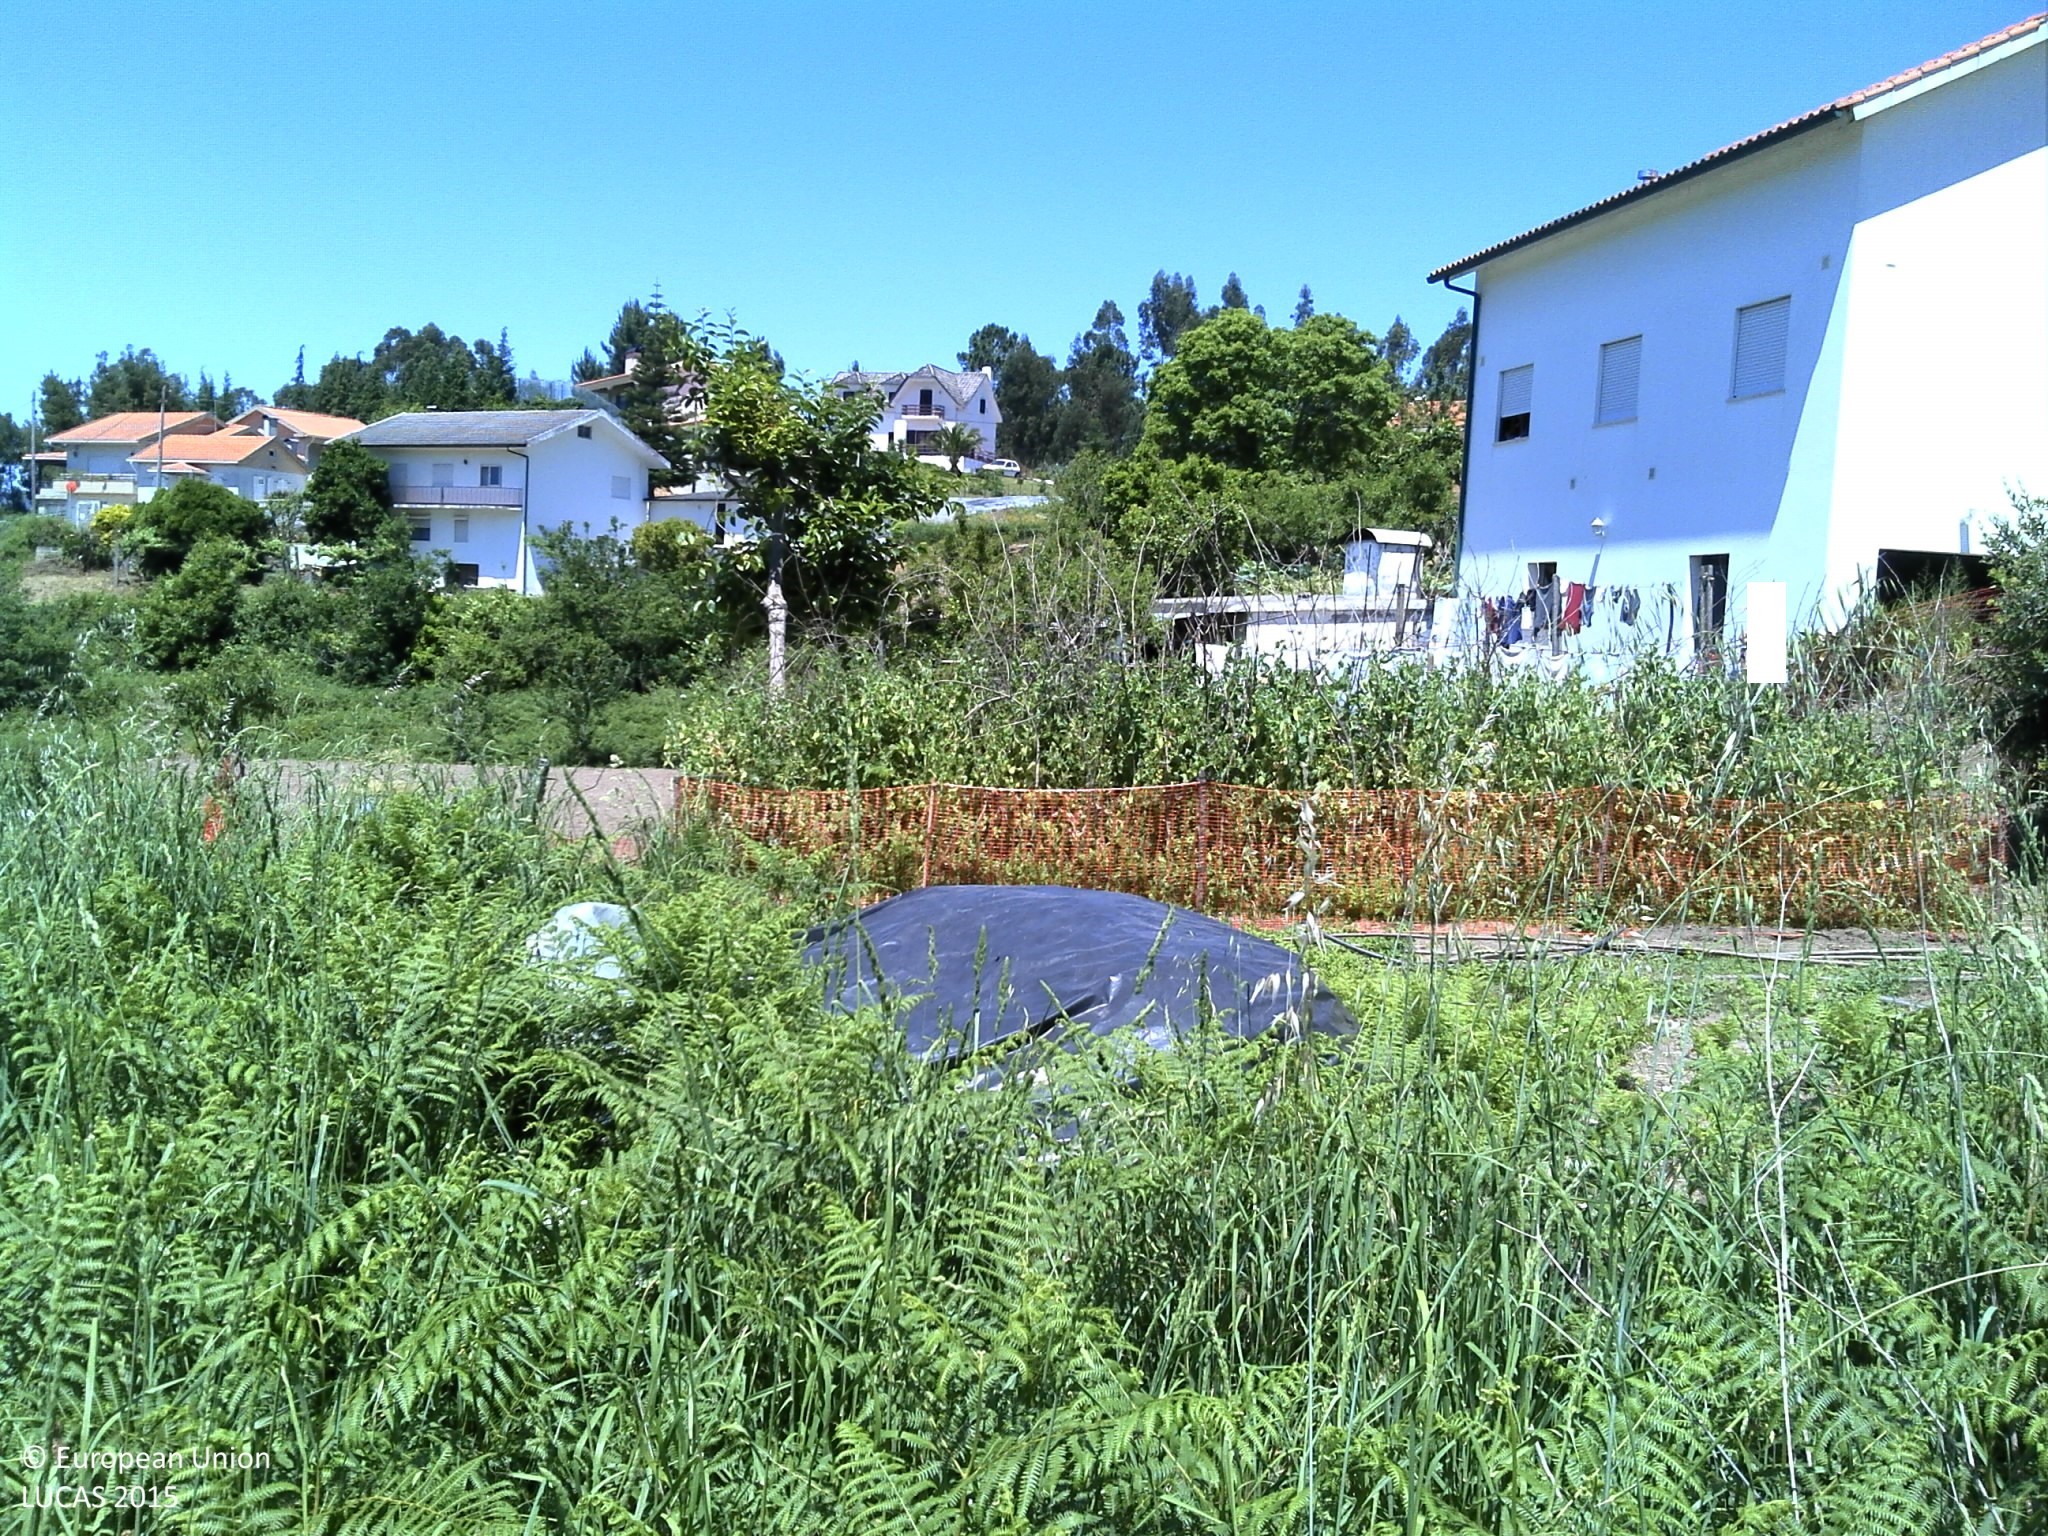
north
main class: Shrubland
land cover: Shrubland without tree cover
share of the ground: 50 - 75 %
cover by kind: shrubs 50 %, herbaceous plants 40 %, unconsolidated bare surface 10 %
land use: Abandoned areas
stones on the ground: < 10 %
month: May
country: PT
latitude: 41.9197
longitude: -8.7506
